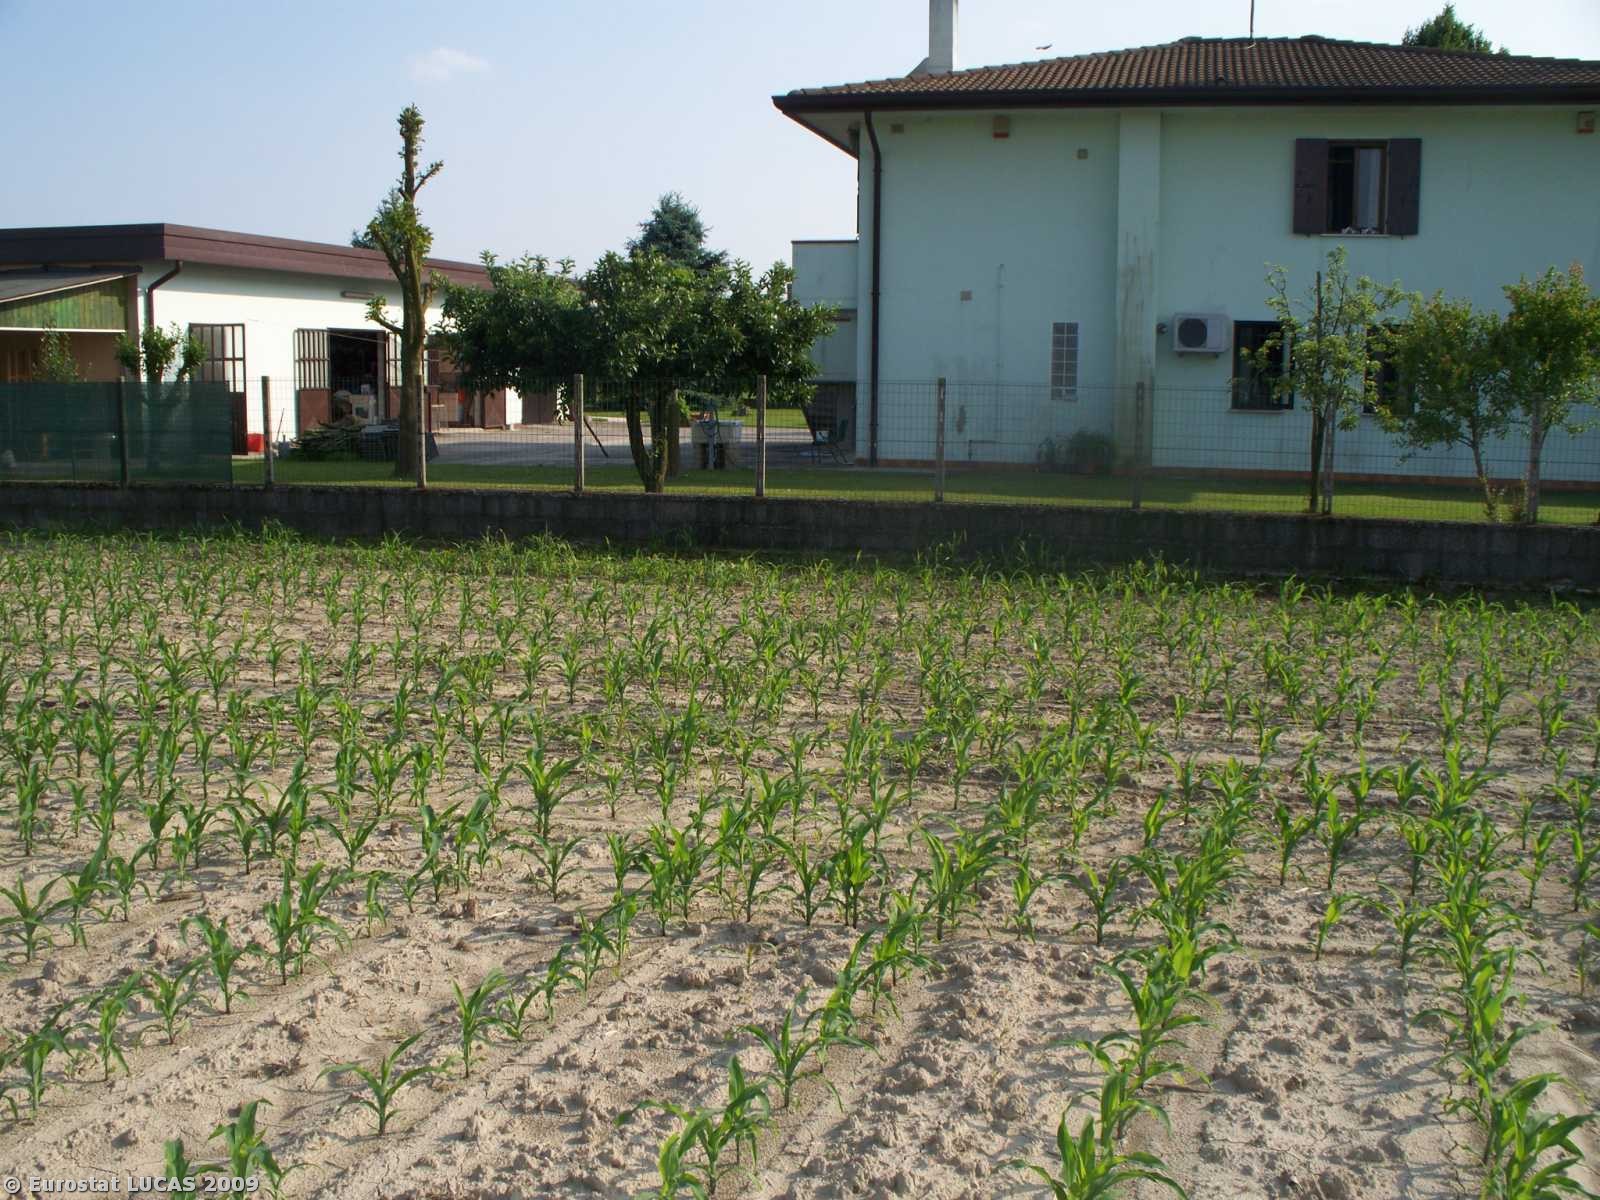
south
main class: Cropland
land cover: Maize
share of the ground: < 10 %
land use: Agriculture (excluding fallow land and kitchen gardens)
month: May
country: IT
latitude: 45.3222
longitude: 12.0505
